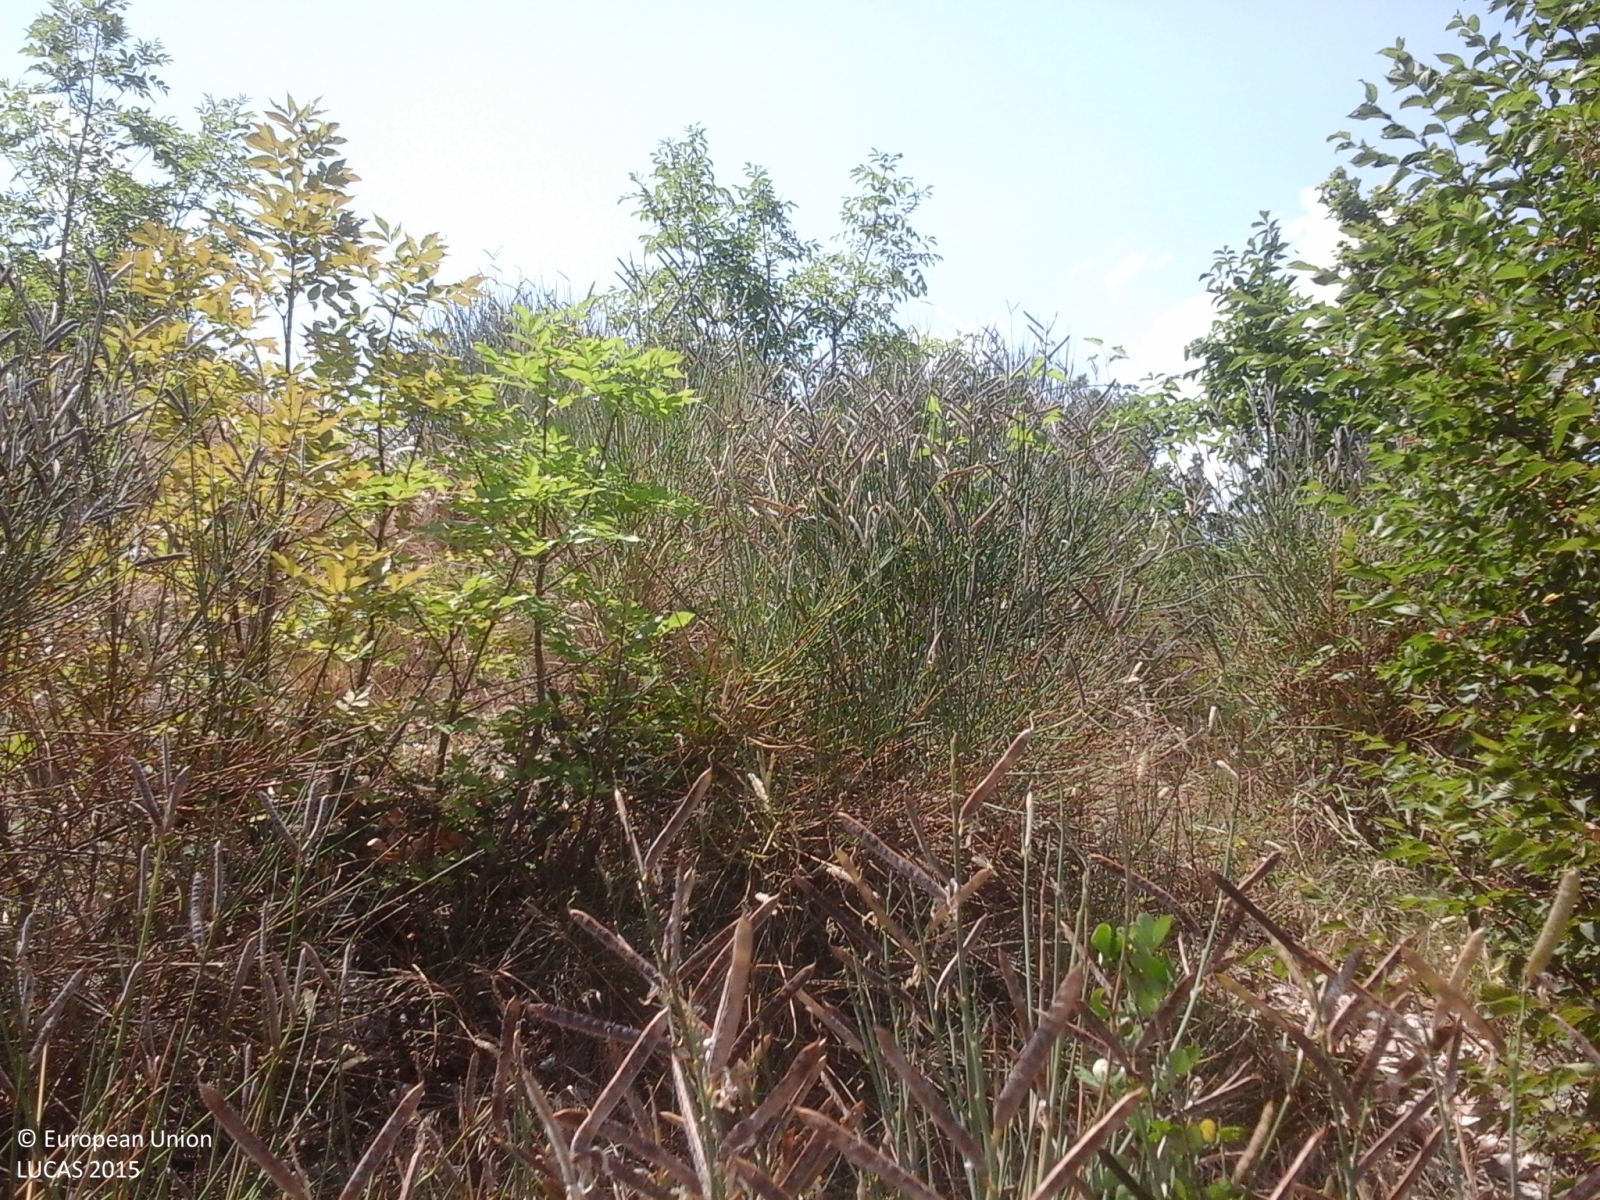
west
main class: Woodland
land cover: Broadleaved woodland
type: thermophilous deciduous forest
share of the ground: > 75 %
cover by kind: broadleaved forest trees 90 %, shrubs 5 %, herbaceous plants 5 %
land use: Forestry
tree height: > 5 m
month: July
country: IT
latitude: 43.0719
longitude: 13.2455
